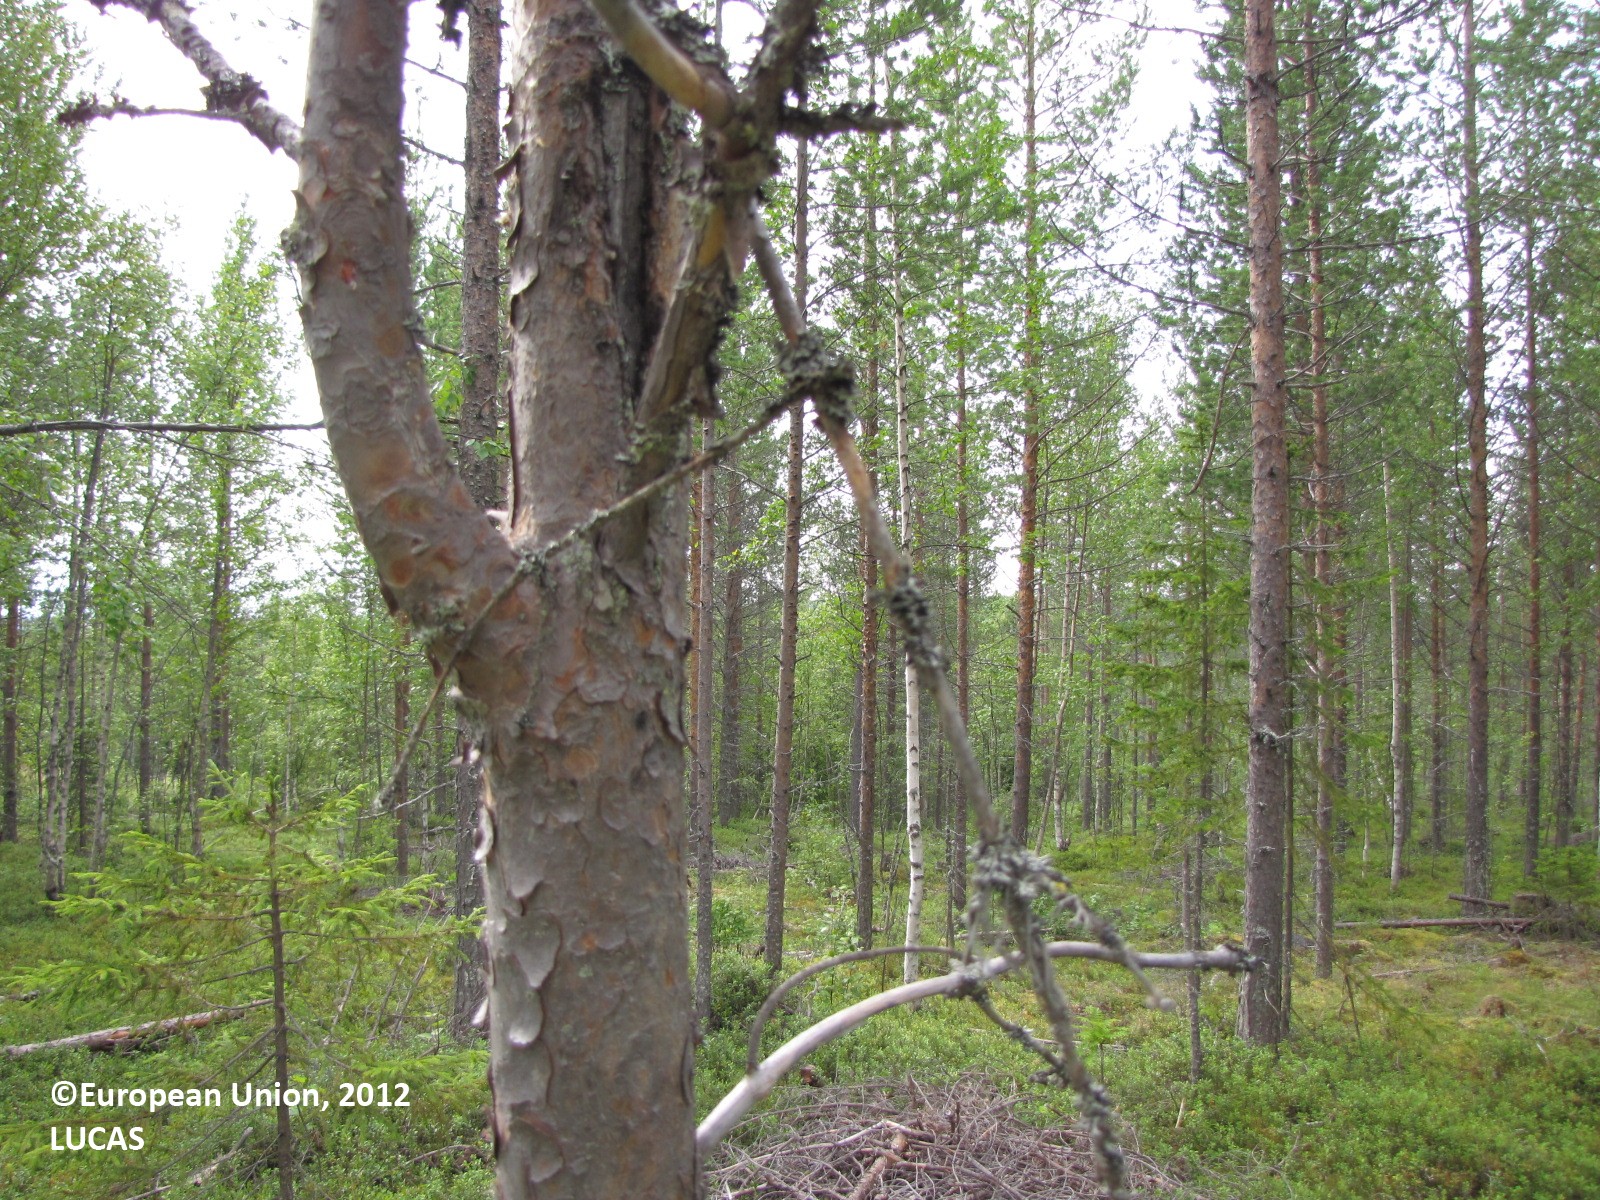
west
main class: Woodland
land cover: Pine dominated mixed woodland
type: boreal forest
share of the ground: 25 - 50 %
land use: Forestry
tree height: > 5 m
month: August
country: FI
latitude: 66.8645
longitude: 24.9411
